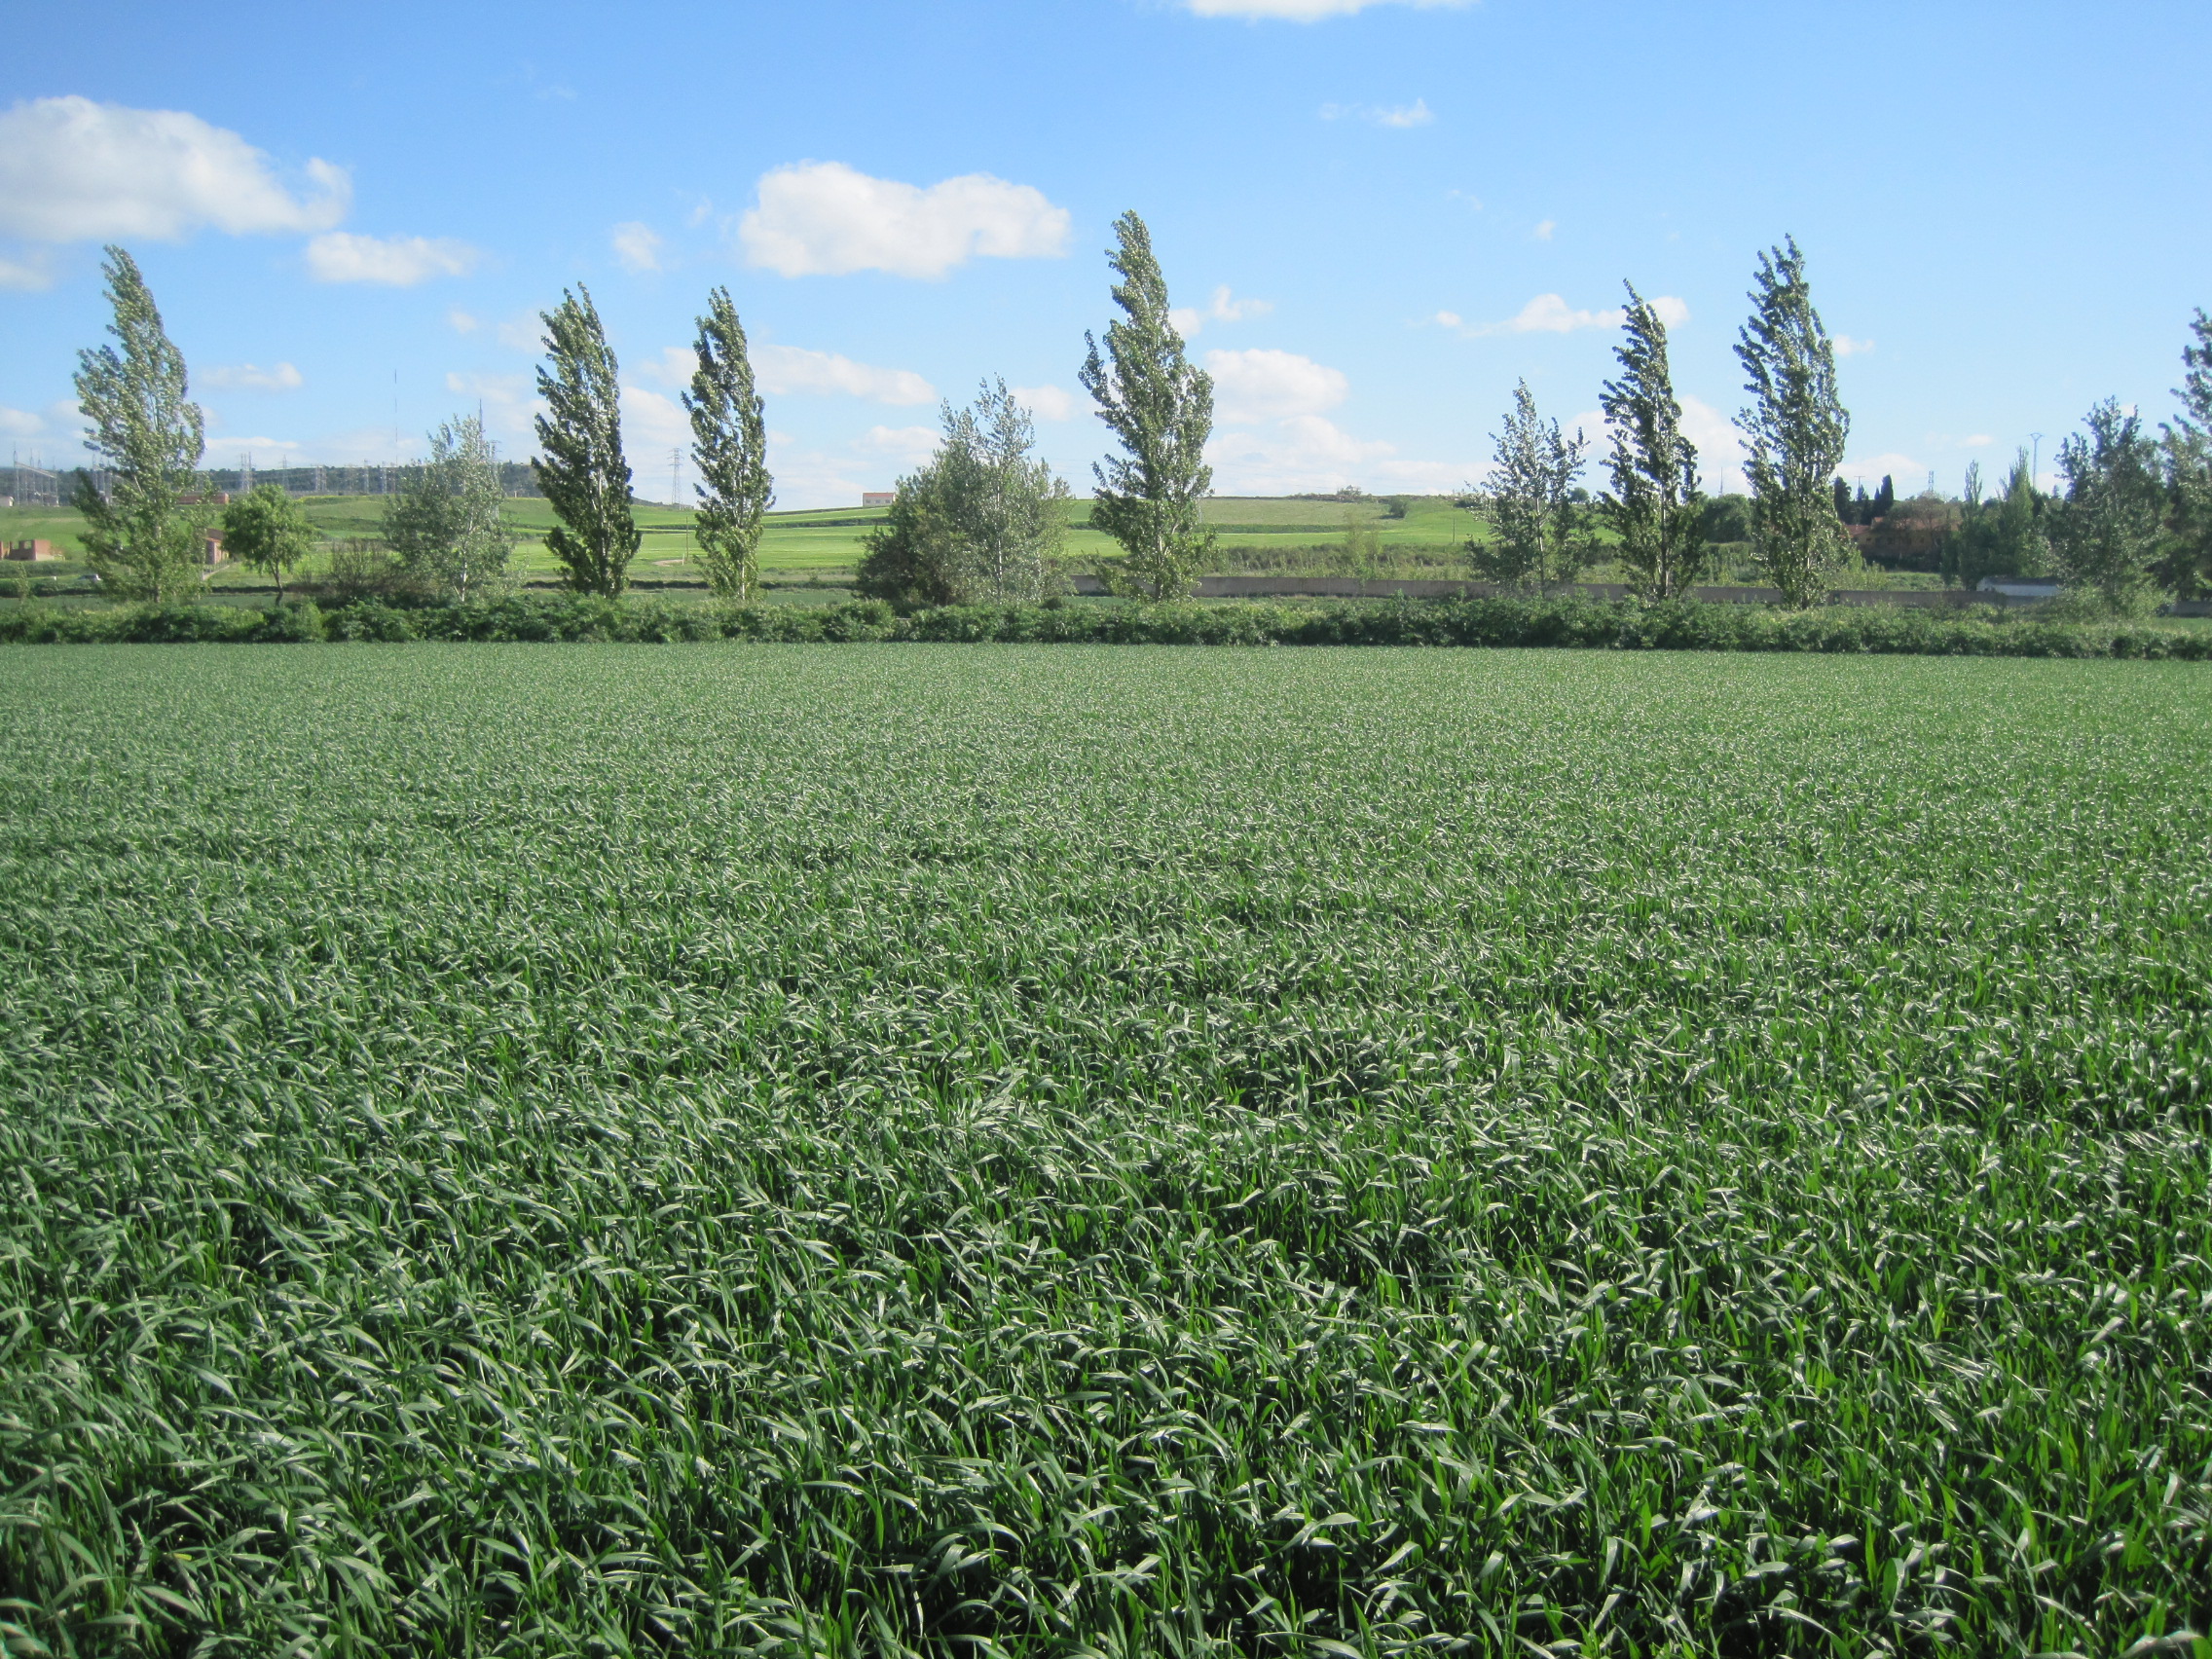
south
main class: Cropland
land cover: Common wheat
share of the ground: > 75 %
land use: Agriculture (excluding fallow land and kitchen gardens)
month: May
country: ES
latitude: 41.6509
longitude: -4.6813
